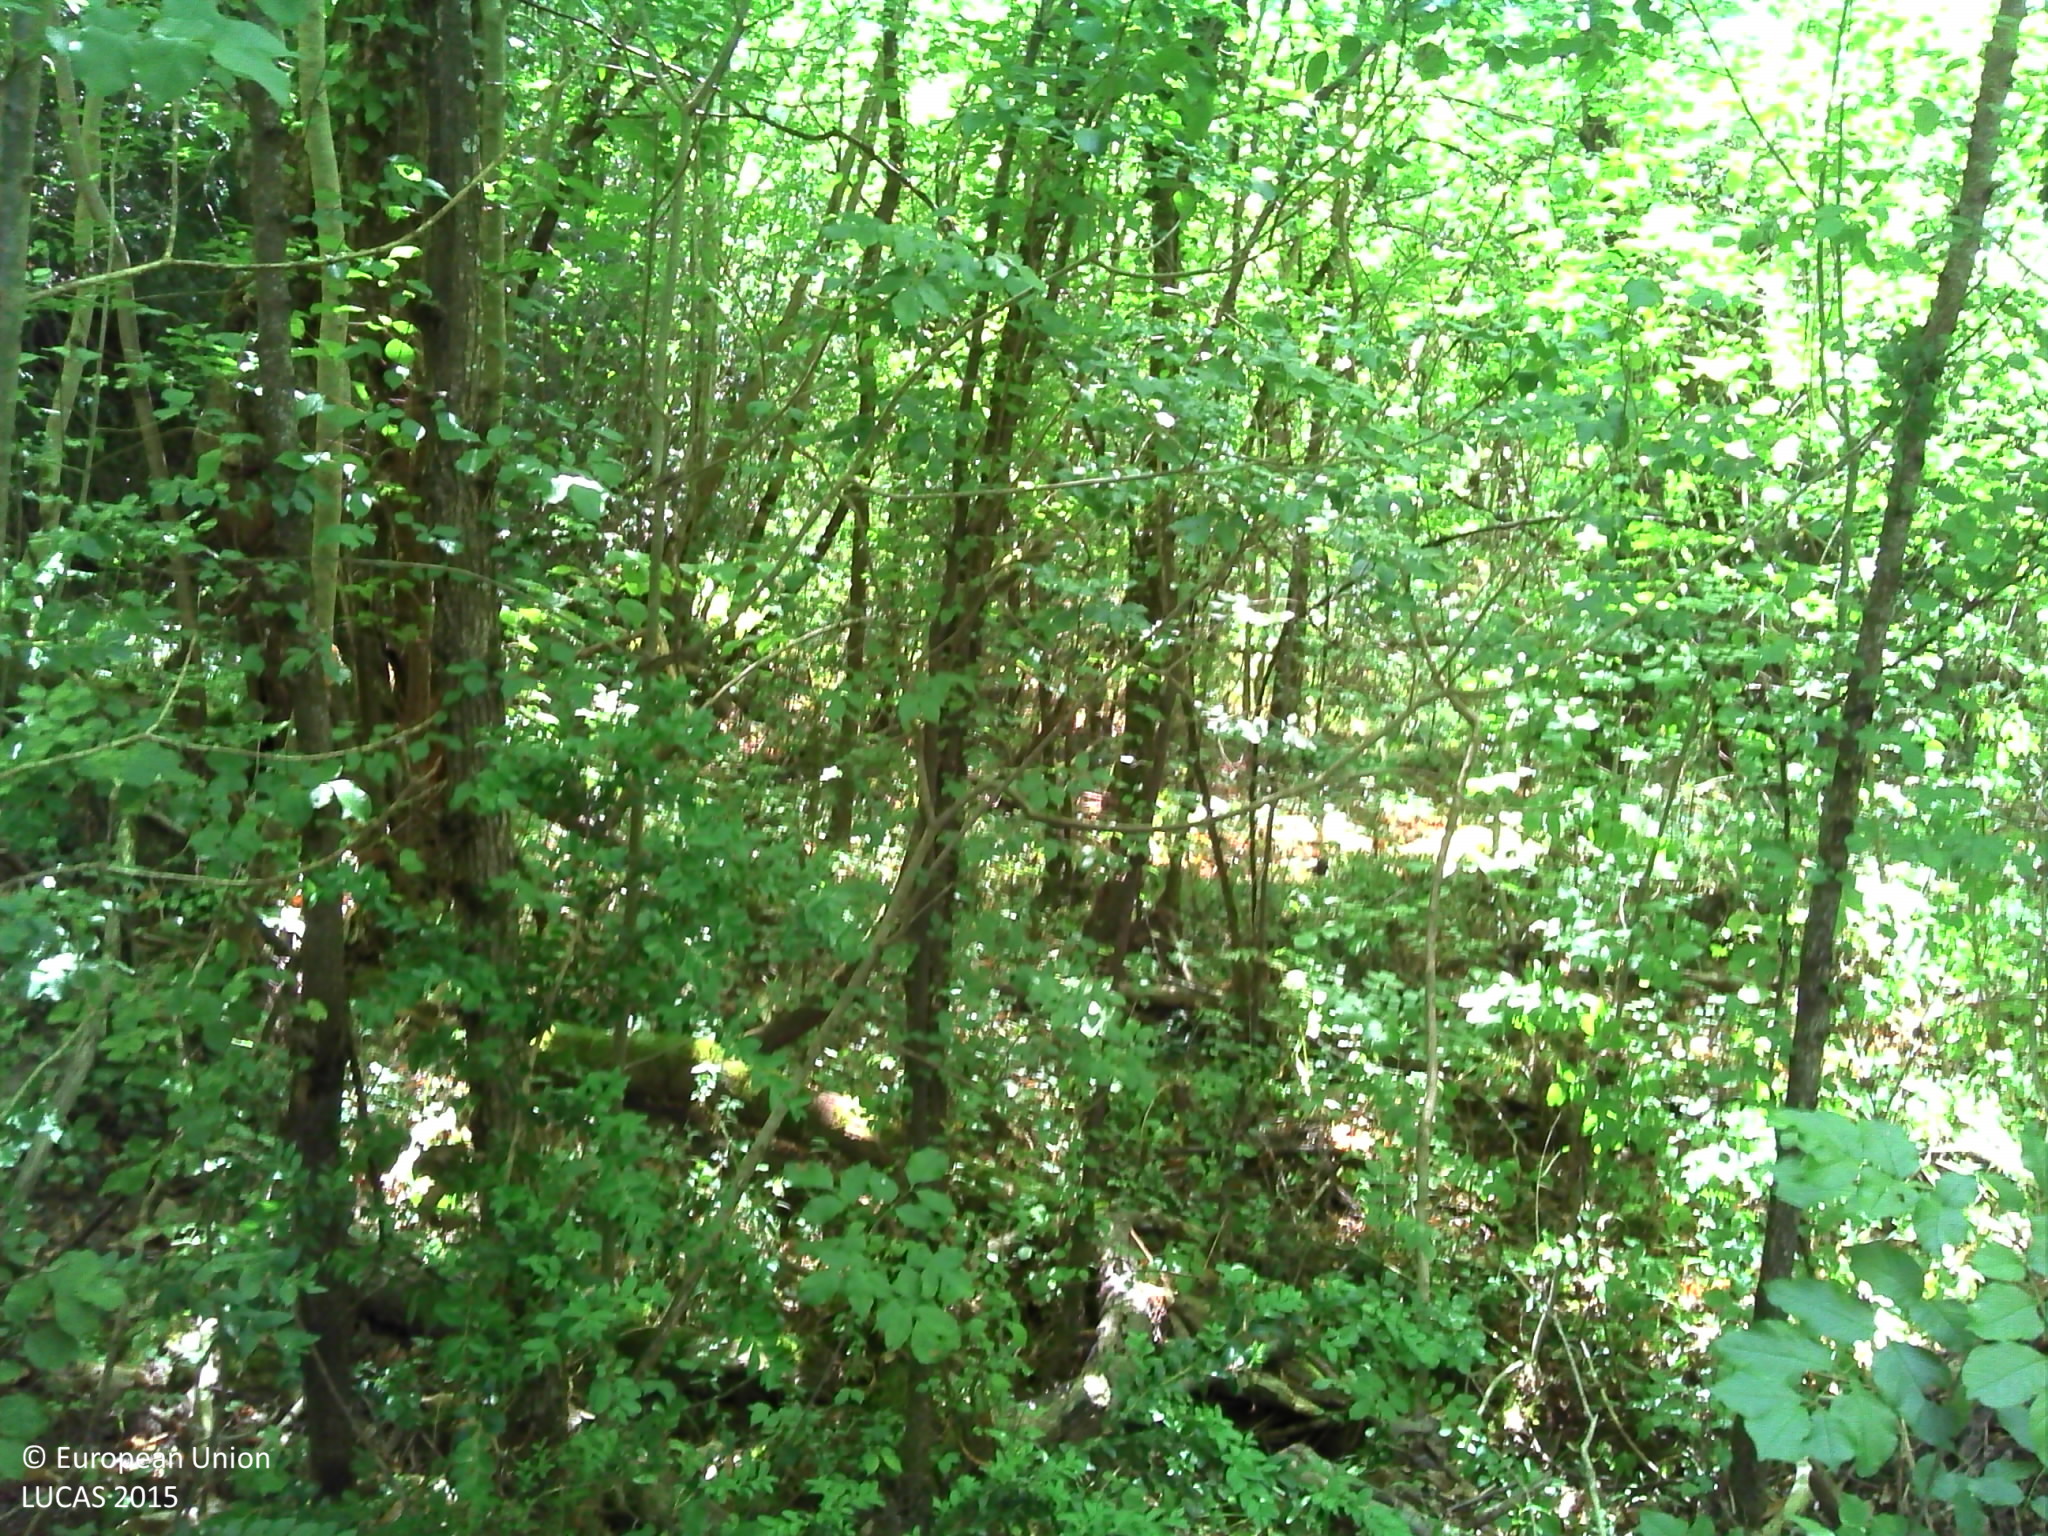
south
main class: Woodland
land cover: Broadleaved woodland
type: mesophytic deciduous forest
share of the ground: > 75 %
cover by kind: broadleaved forest trees 80 %, shrubs 10 %, coniferous forest trees 5 %, lichens and mosses 5 %
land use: Semi-natural and natural areas not in use
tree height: > 5 m
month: August
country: FR
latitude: 43.8804
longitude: 3.0245
